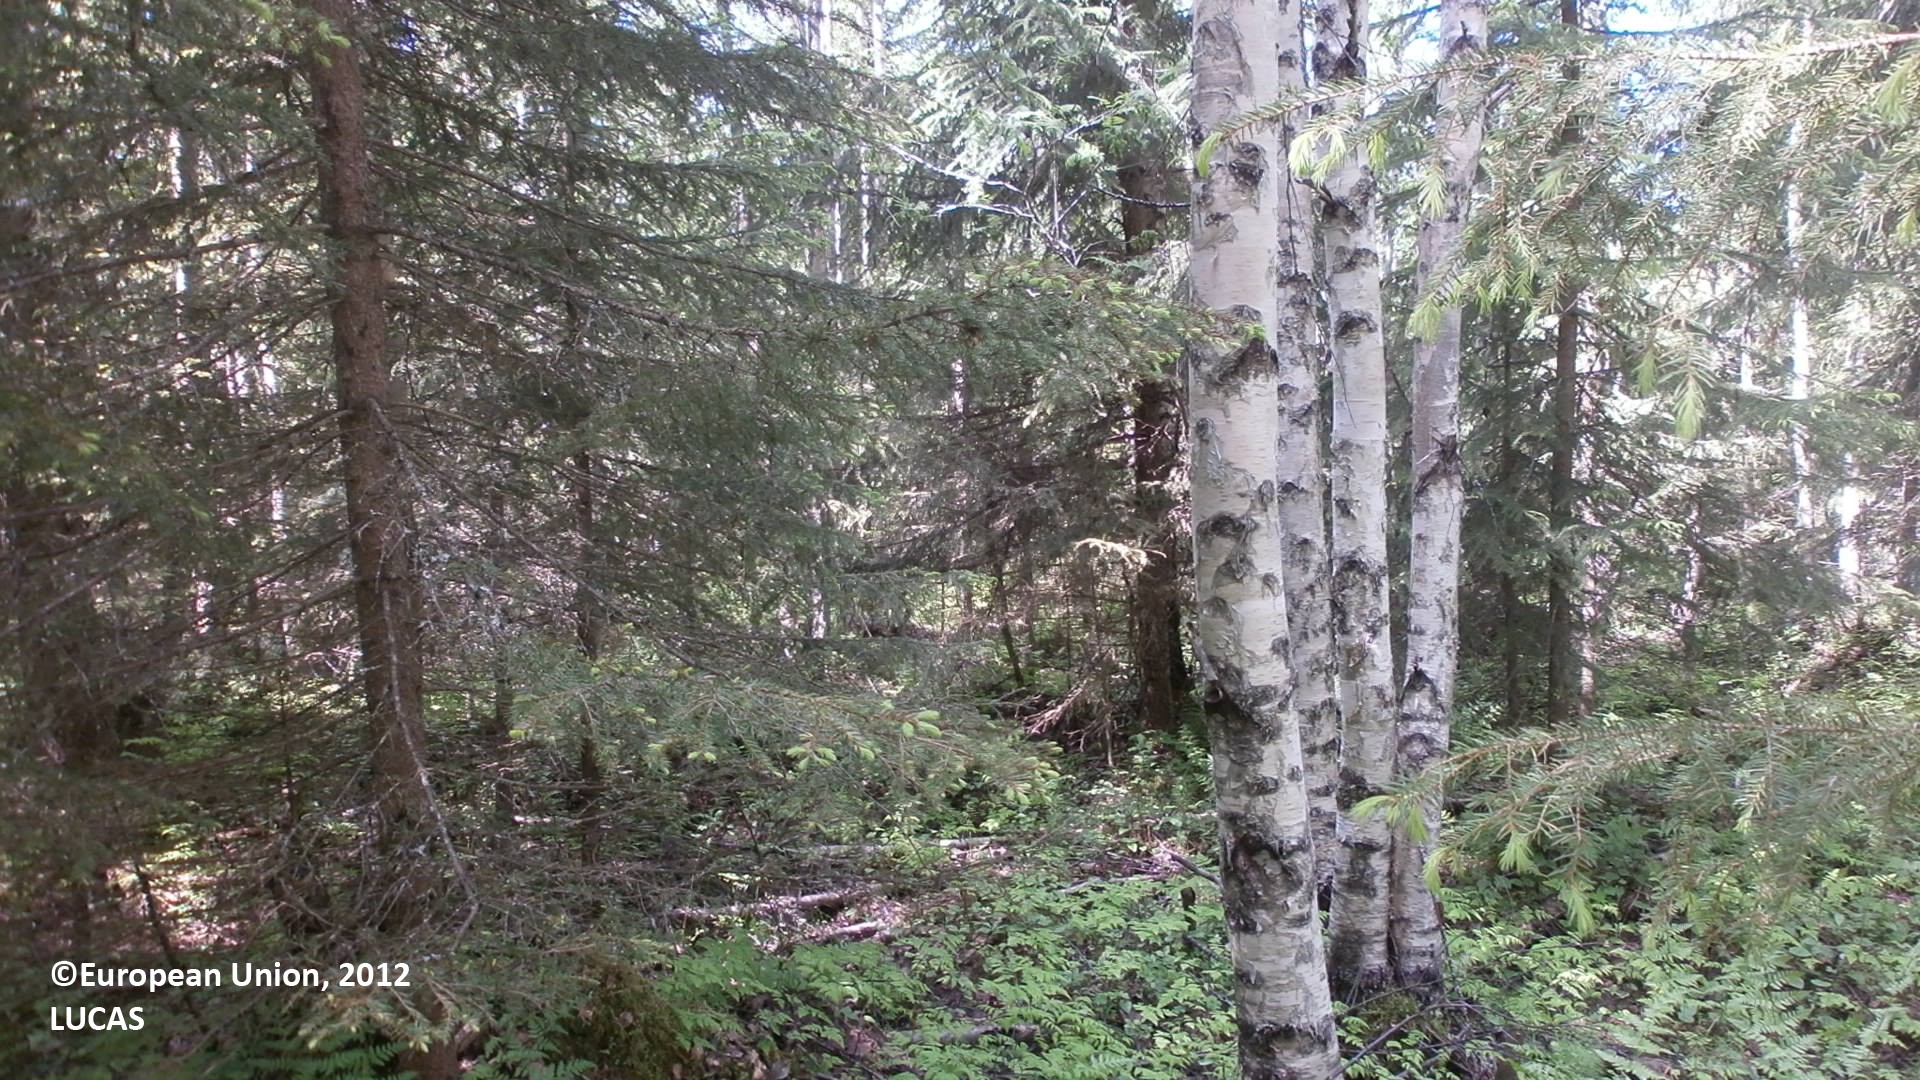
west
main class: Woodland
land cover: Spruce dominated mixed woodland
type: hemiboreal forest and nemoral coniferous forest and mixed broadleaved-coniferous forest
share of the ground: > 75 %
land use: Forestry
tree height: > 5 m
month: June
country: FI
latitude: 64.2429
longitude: 25.8378
